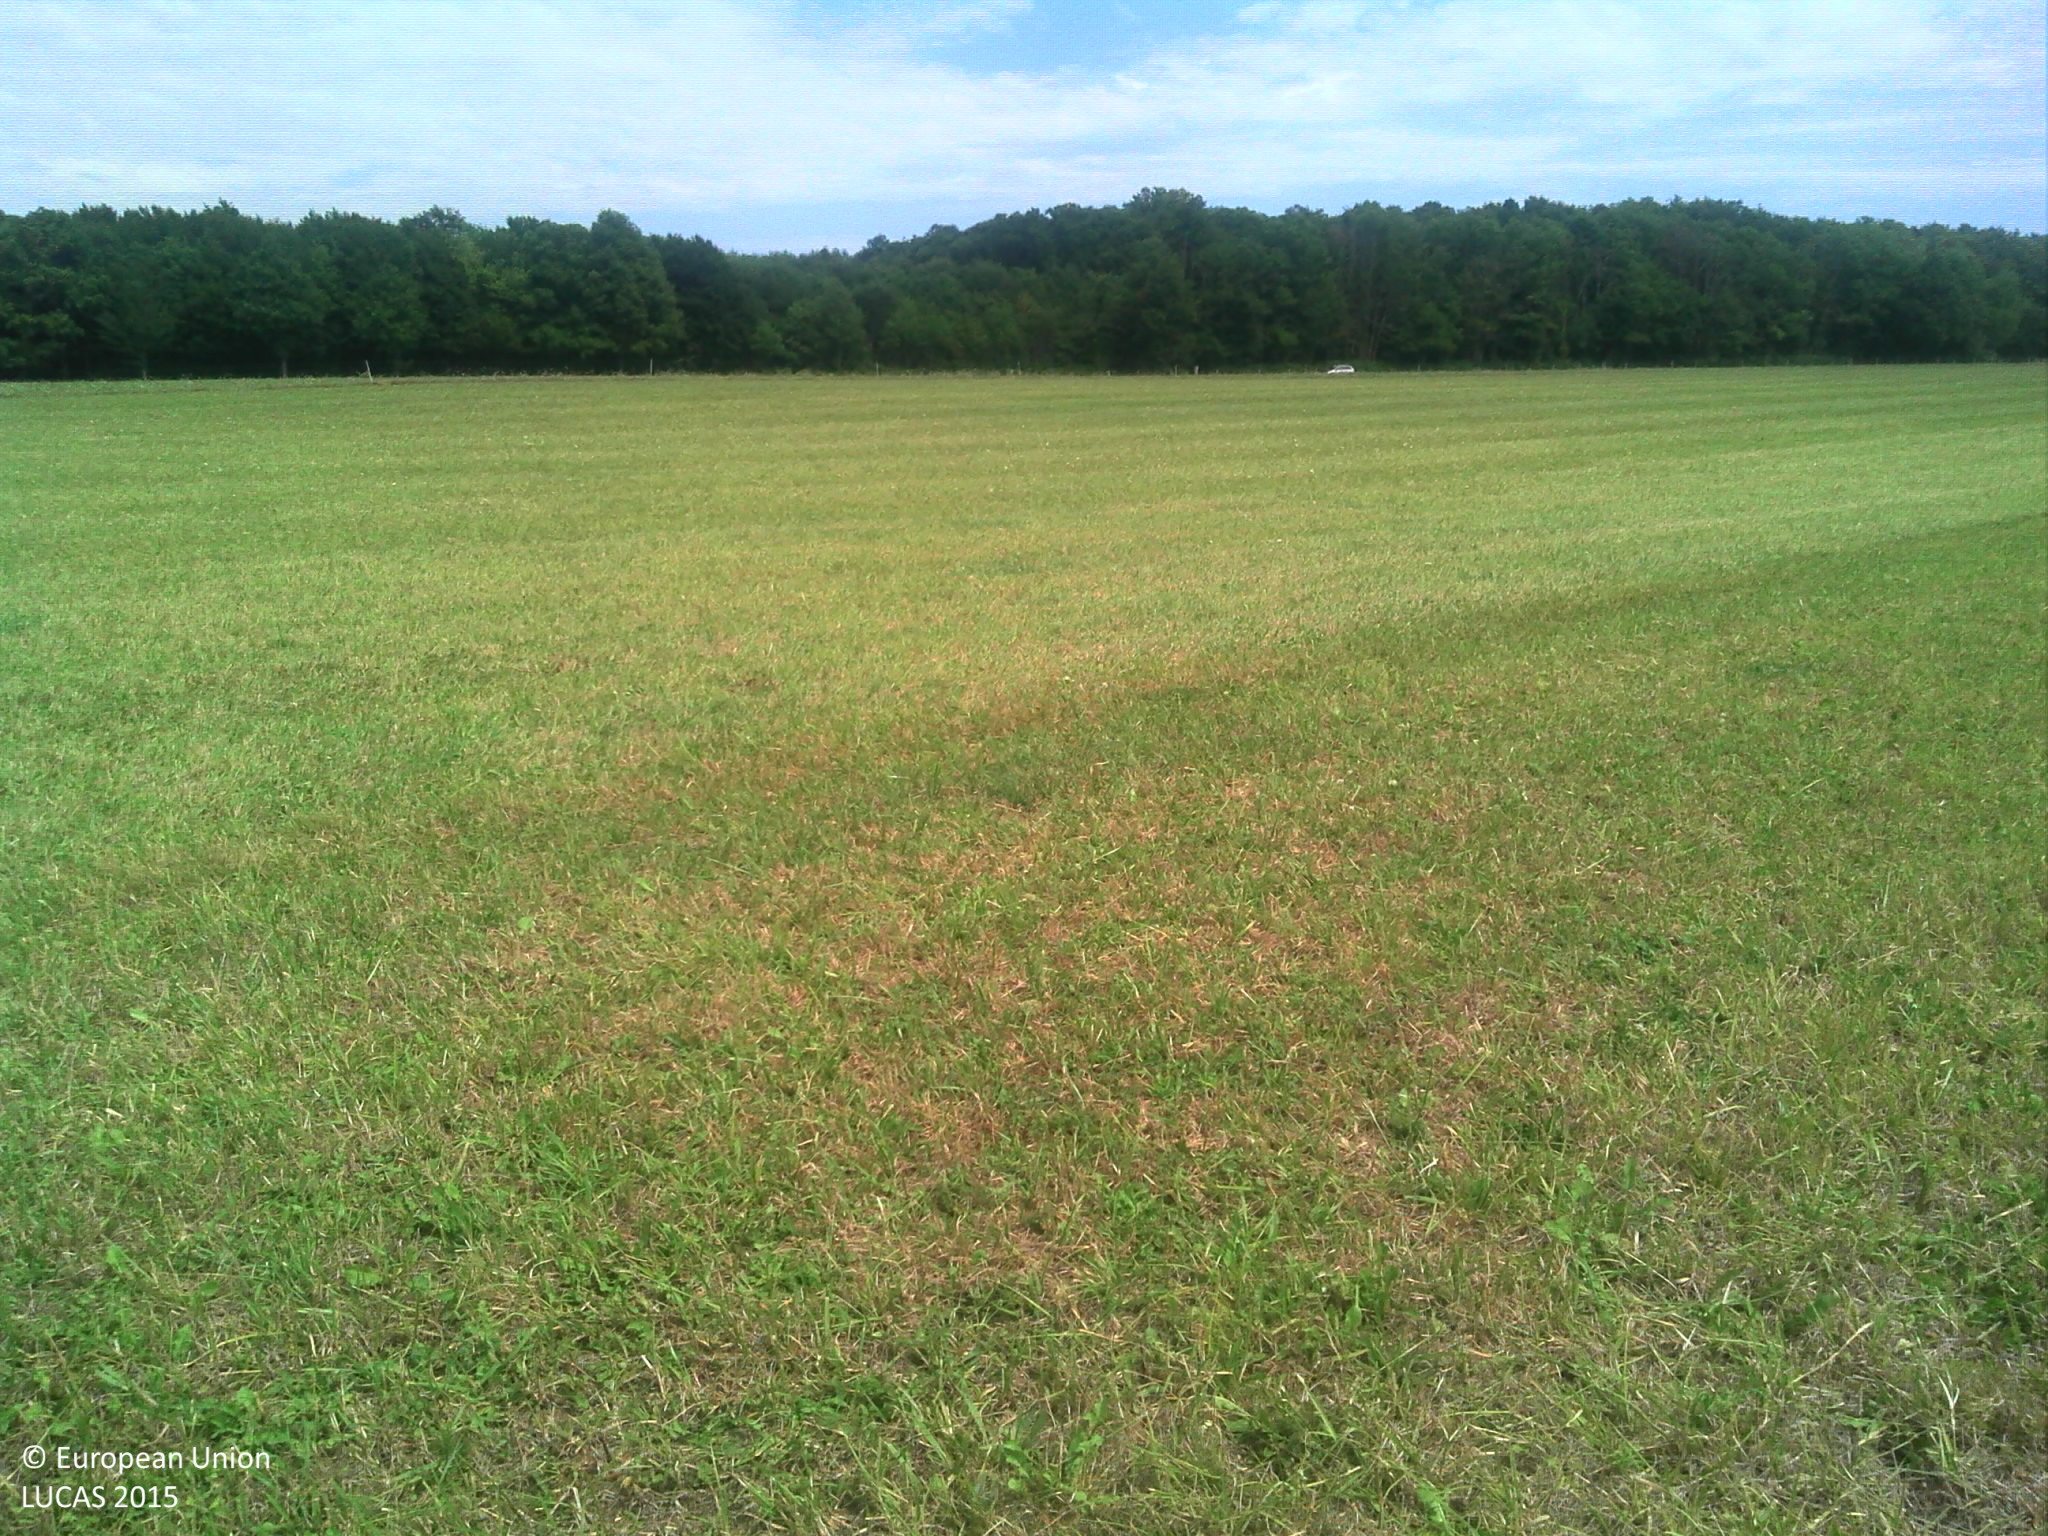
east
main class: Grassland
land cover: Grassland without tree/shrub cover
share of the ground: > 75 %
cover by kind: herbaceous plants 100 %
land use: Agriculture (excluding fallow land and kitchen gardens)
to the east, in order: Grassland without tree/shrub cover; Fences; Grassland without tree/shrub cover; Fences; Tracks; Broadleaved woodland
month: August
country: FR
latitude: 46.0555
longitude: 0.9270
